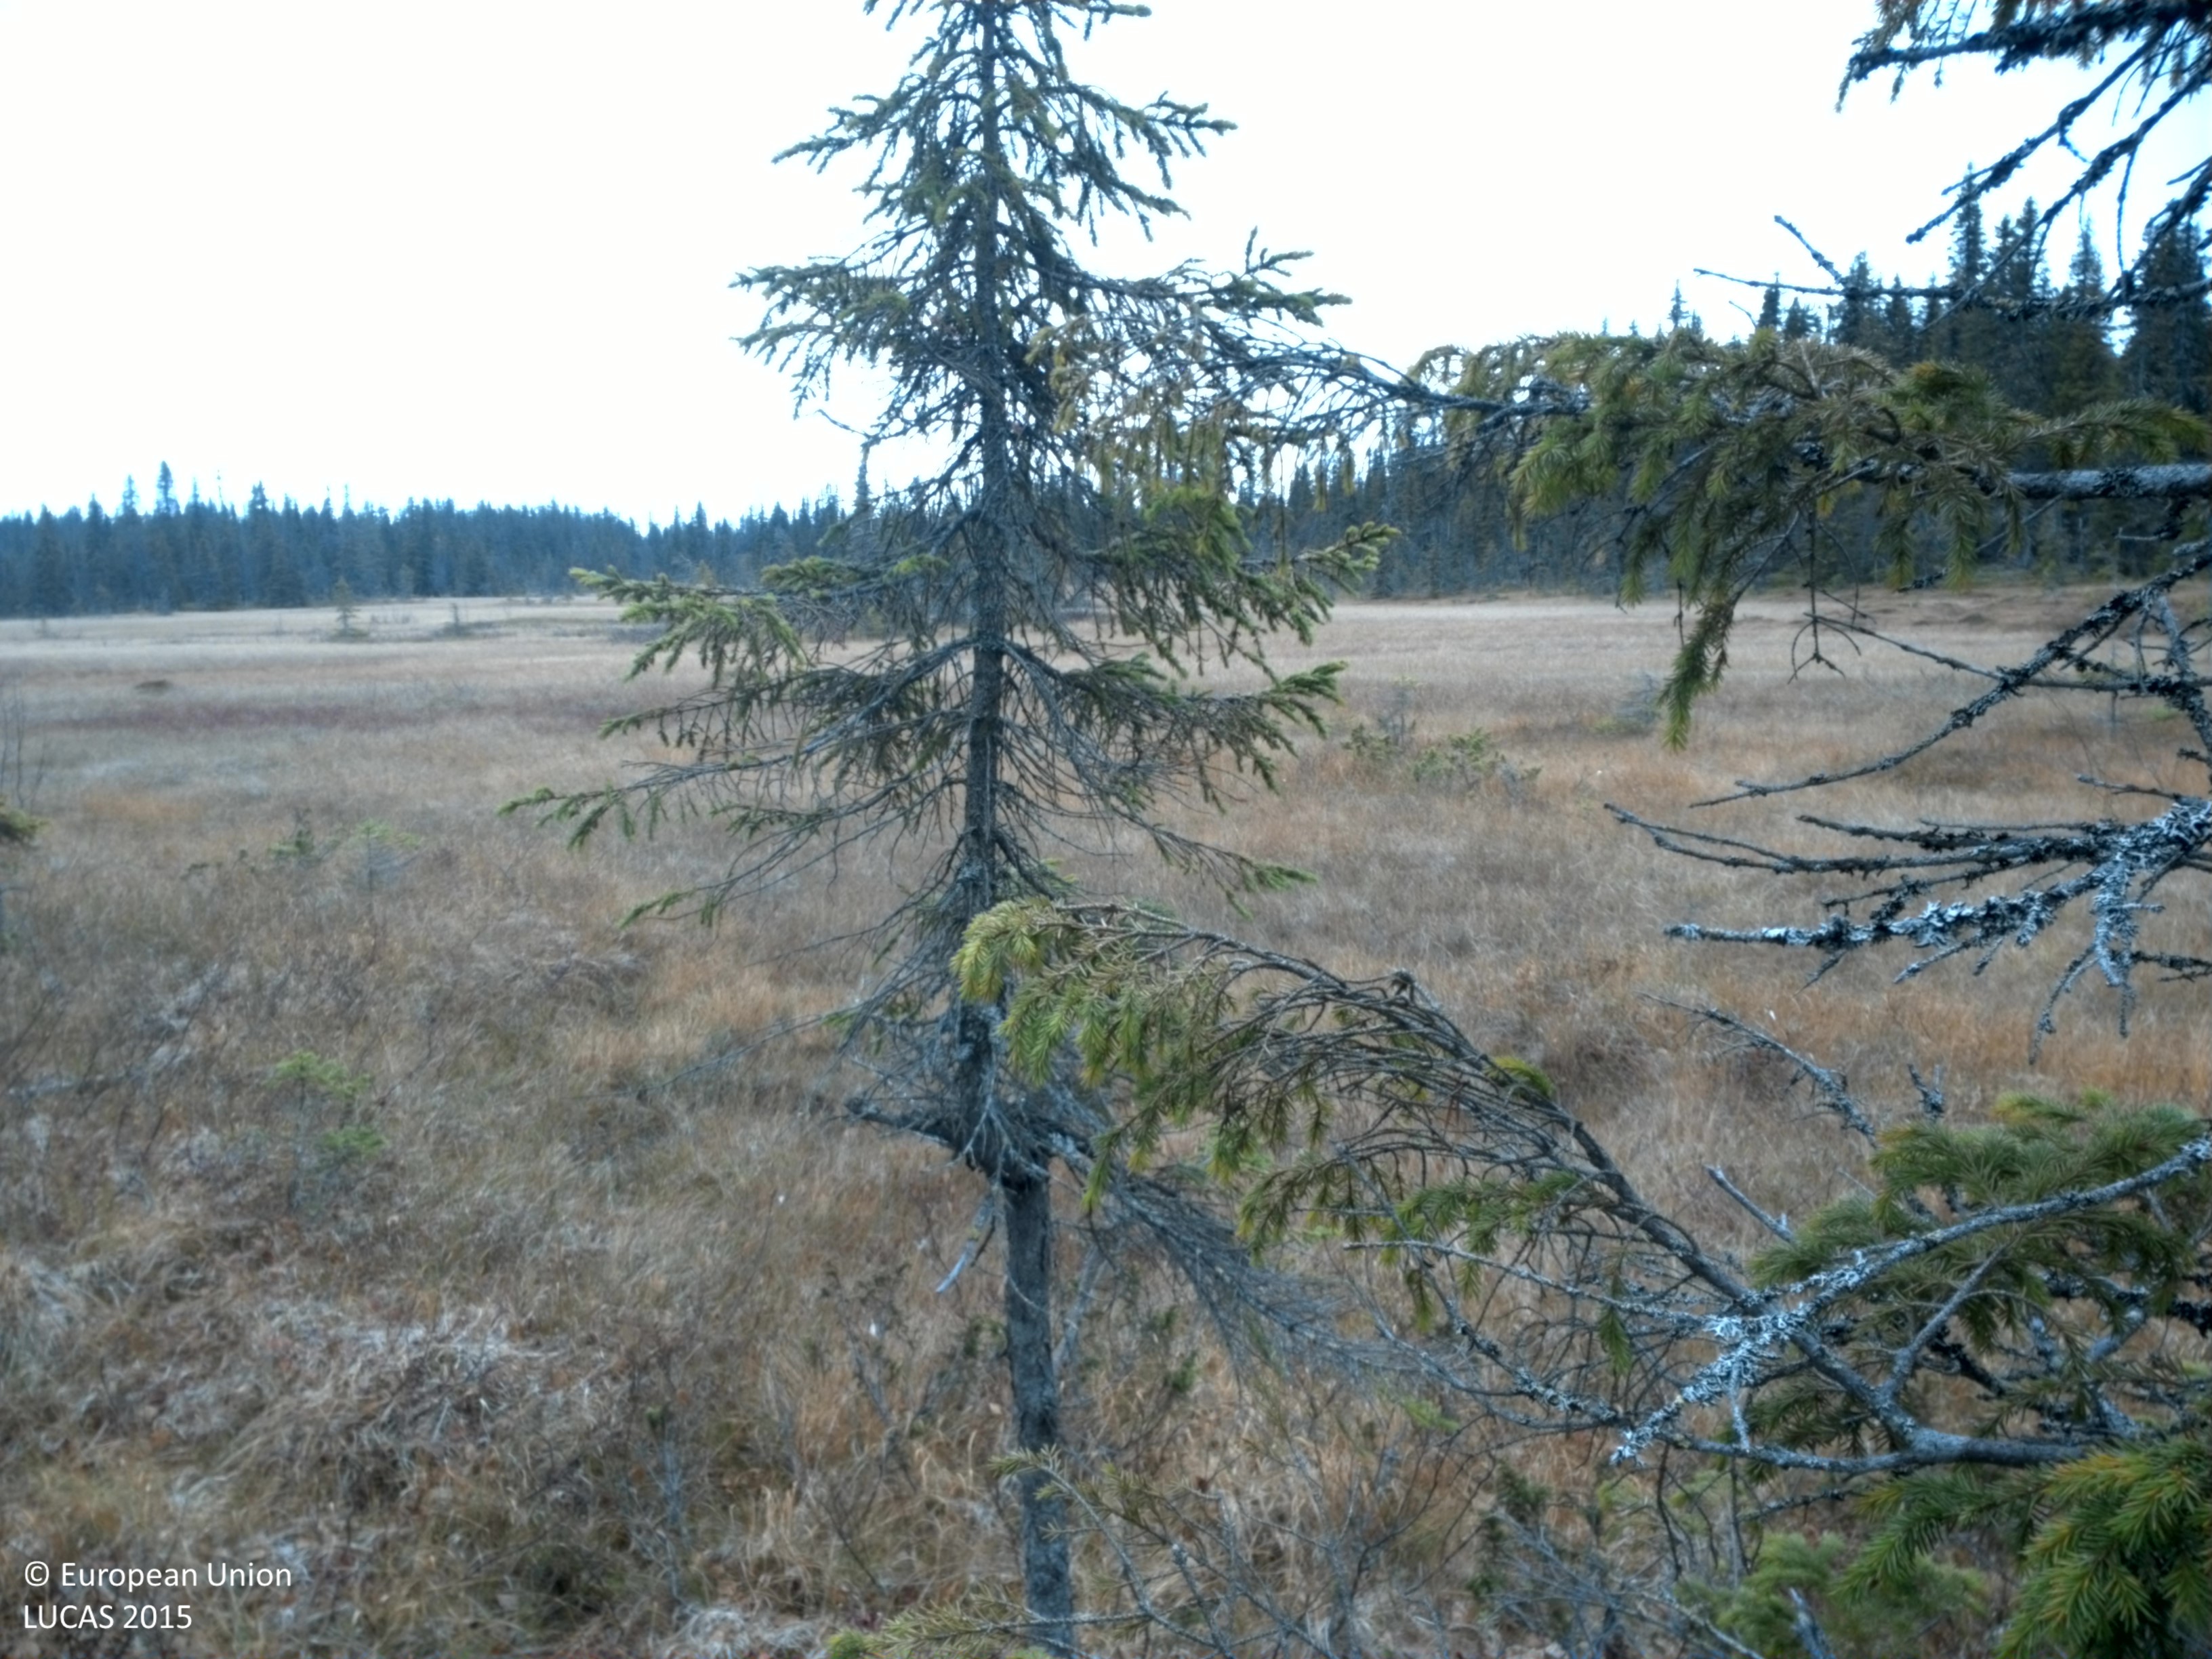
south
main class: Woodland
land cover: Spruce dominated mixed woodland
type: boreal forest
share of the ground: 25 - 50 %
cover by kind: shrubs 40 %, coniferous forest trees 20 %, broadleaved forest trees 20 %, herbaceous plants 10 %, lichens and mosses 10 %
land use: Forestry
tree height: > 5 m
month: October
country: SE
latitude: 64.8842
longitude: 16.8696
